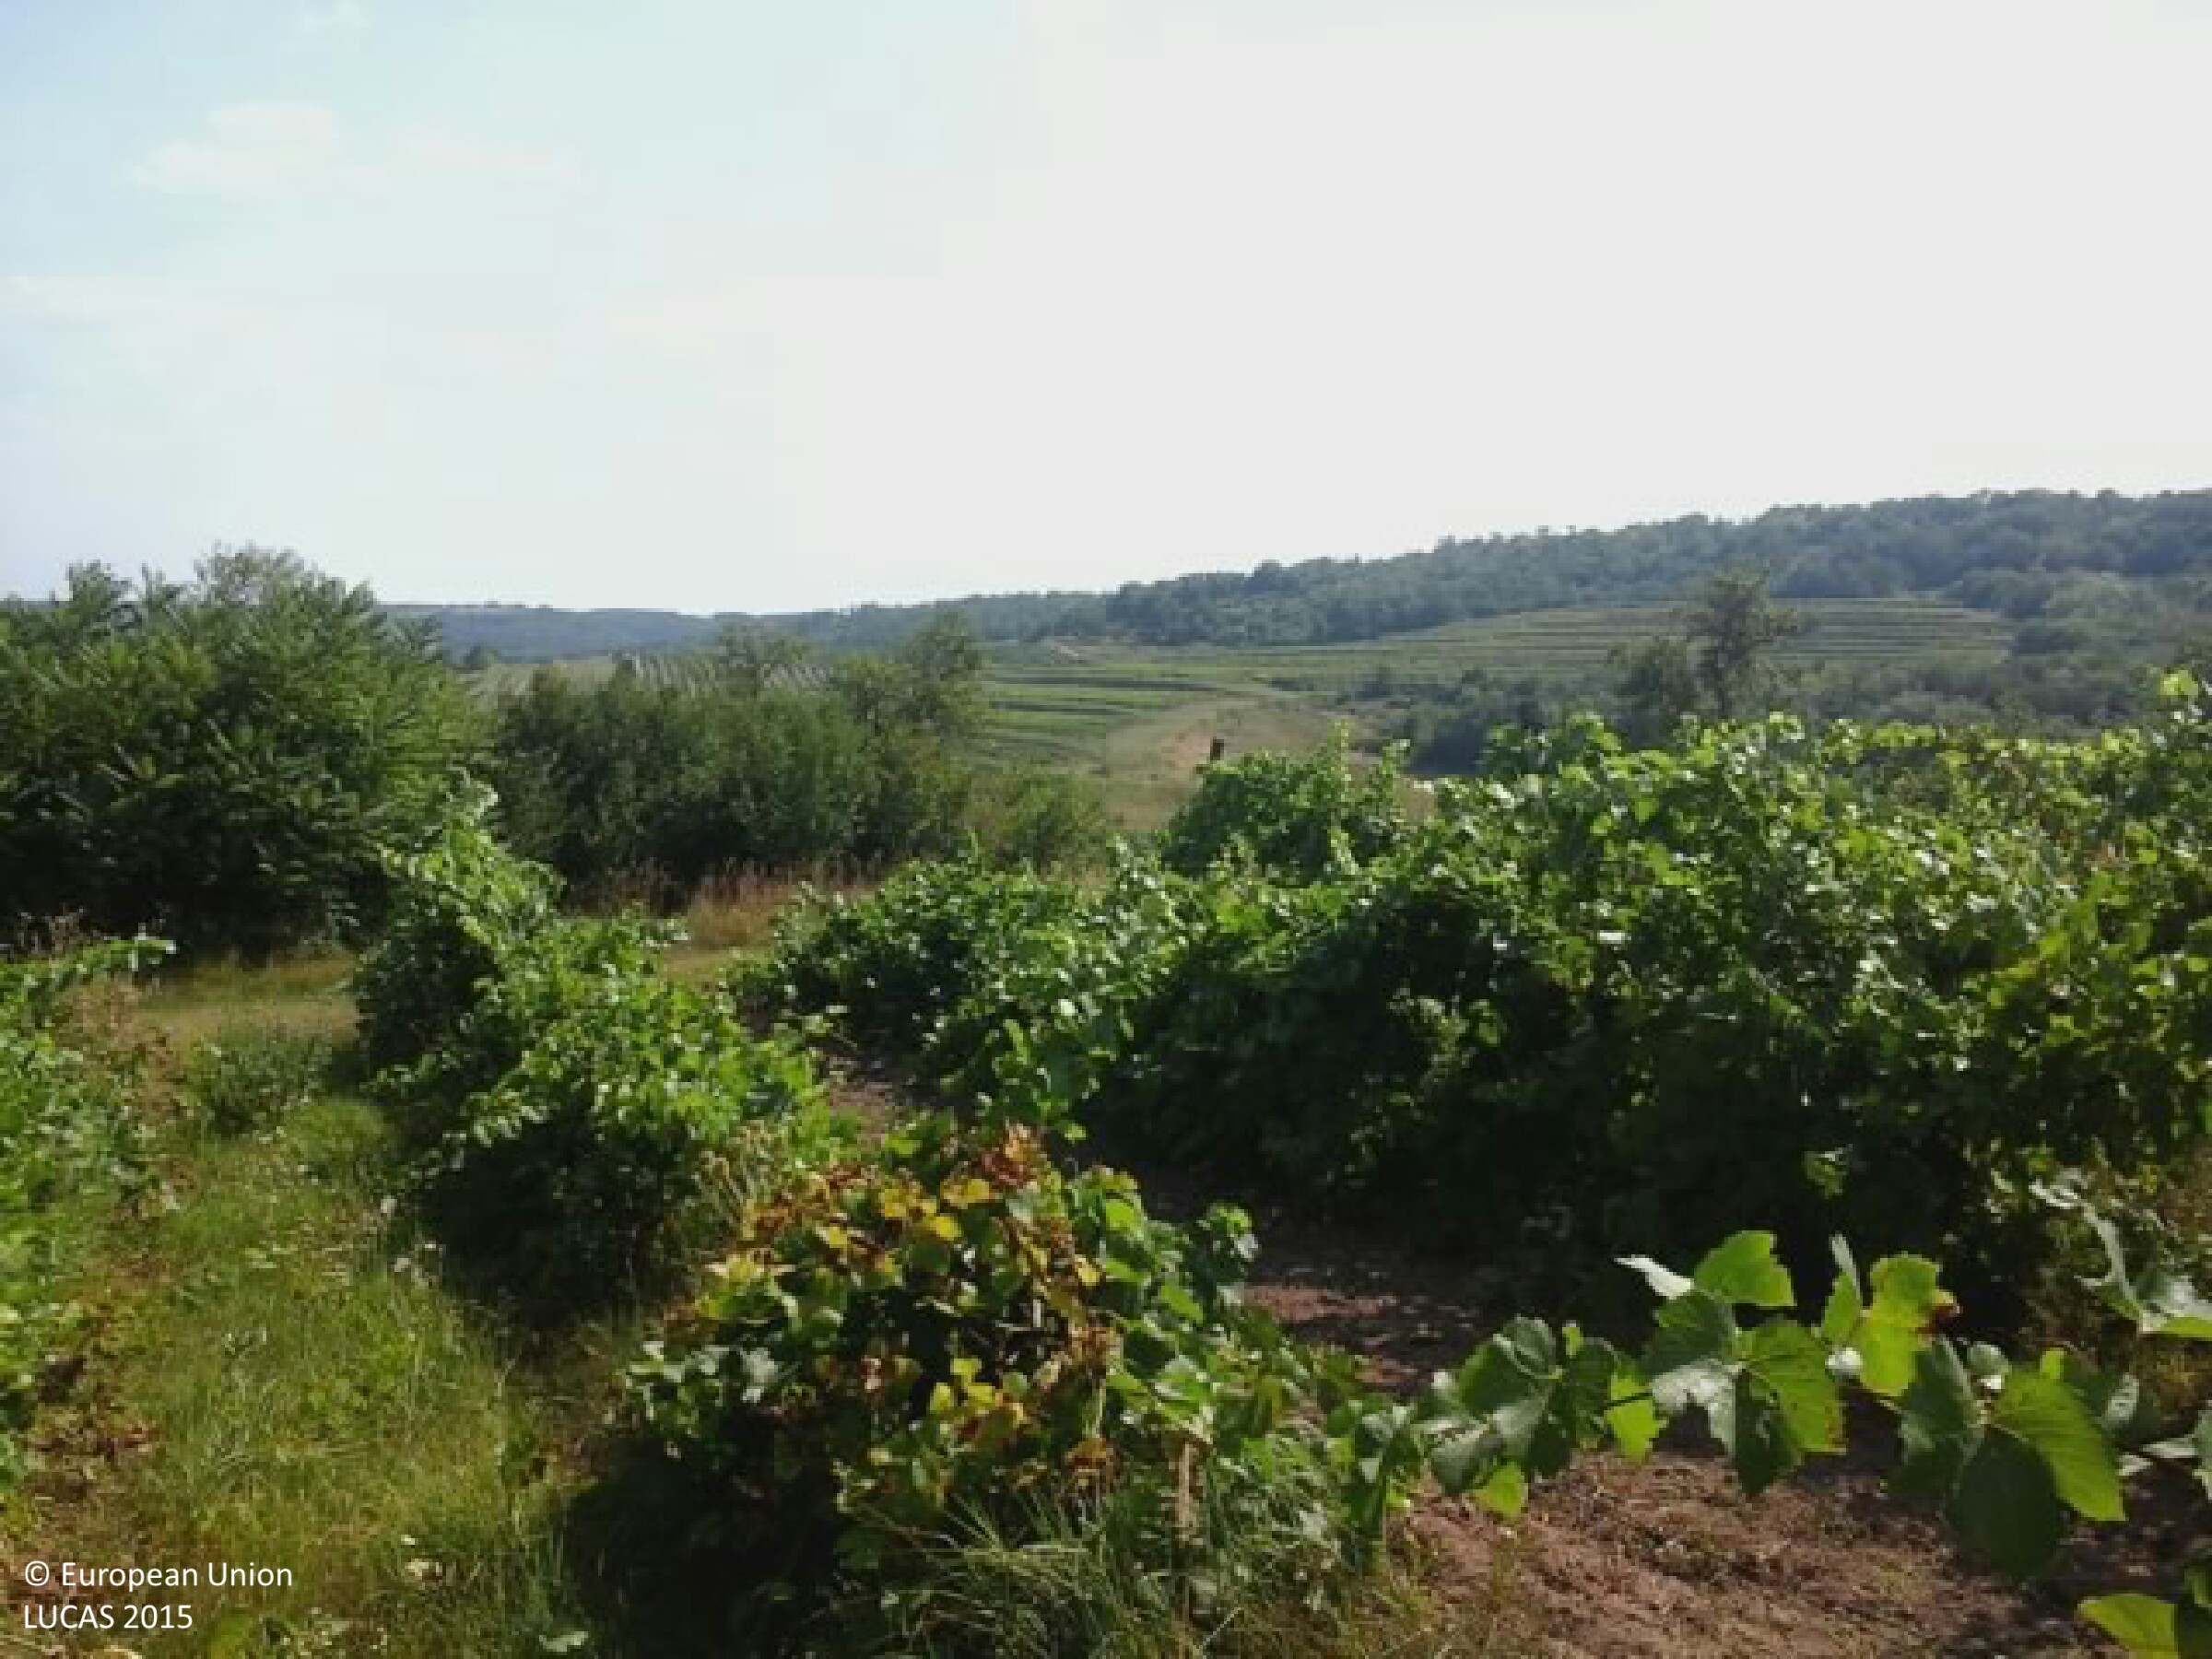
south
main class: Cropland
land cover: Vineyards
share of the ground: 50 - 75 %
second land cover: Grassland without tree/shrub cover
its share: 50 - 75 %
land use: Agriculture (excluding fallow land and kitchen gardens)
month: August
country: HU
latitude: 46.7724
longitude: 18.2733
